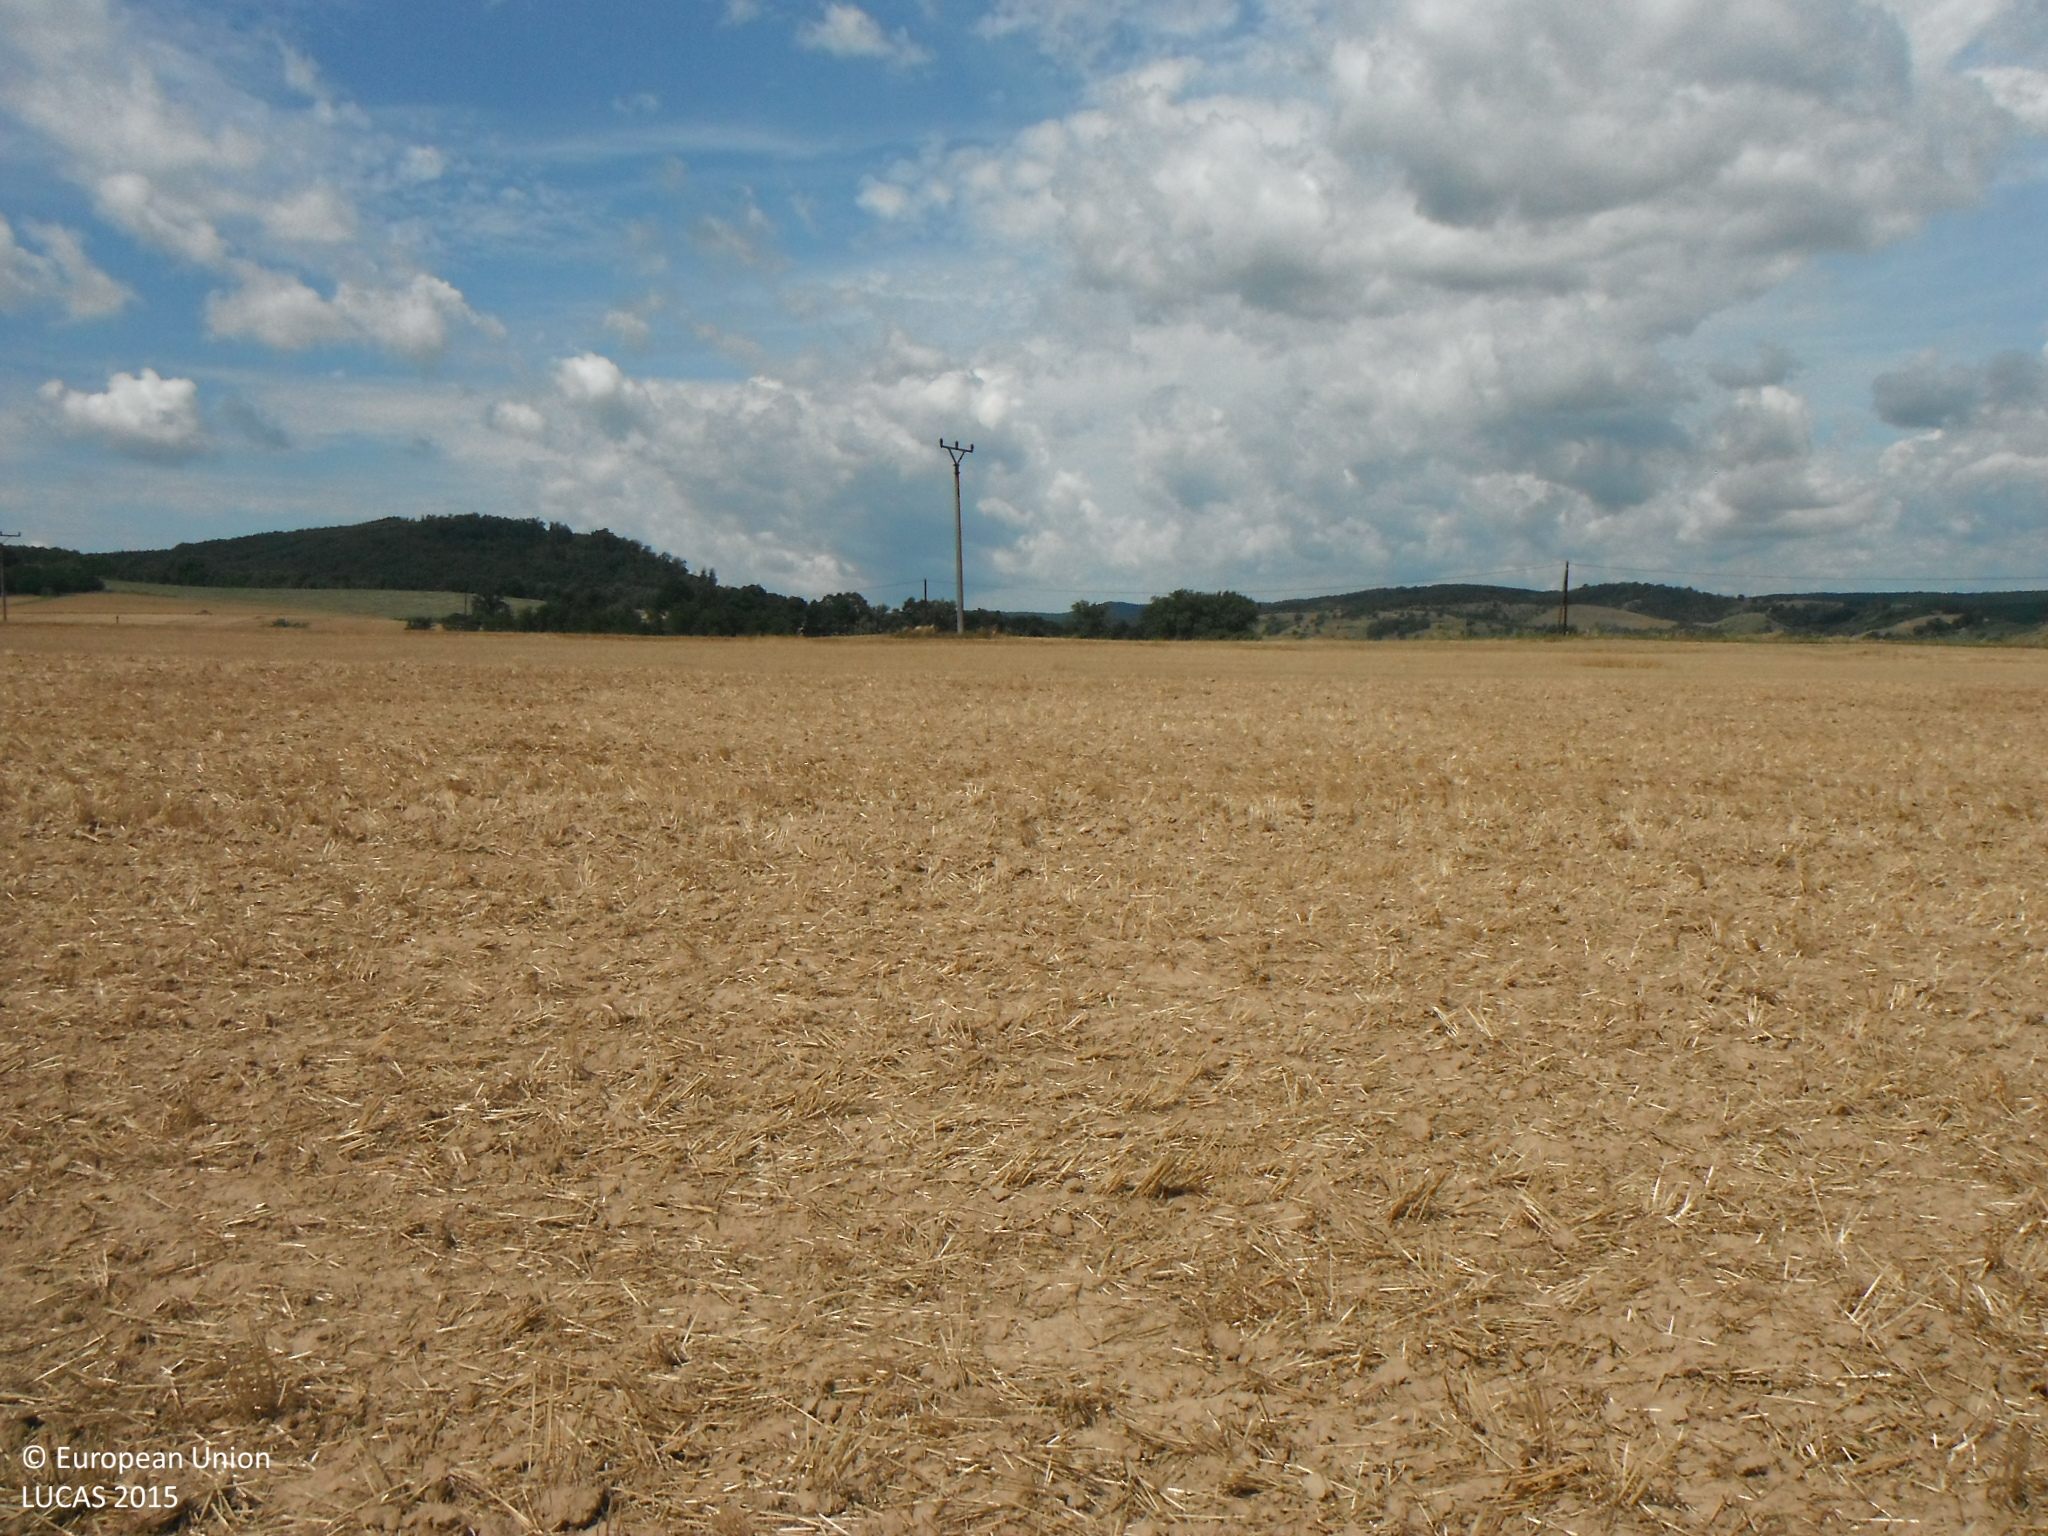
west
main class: Cropland
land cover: Common wheat
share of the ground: > 75 %
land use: Agriculture (excluding fallow land and kitchen gardens)
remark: Harvested field
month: July
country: SK
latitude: 48.2920
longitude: 20.0168
